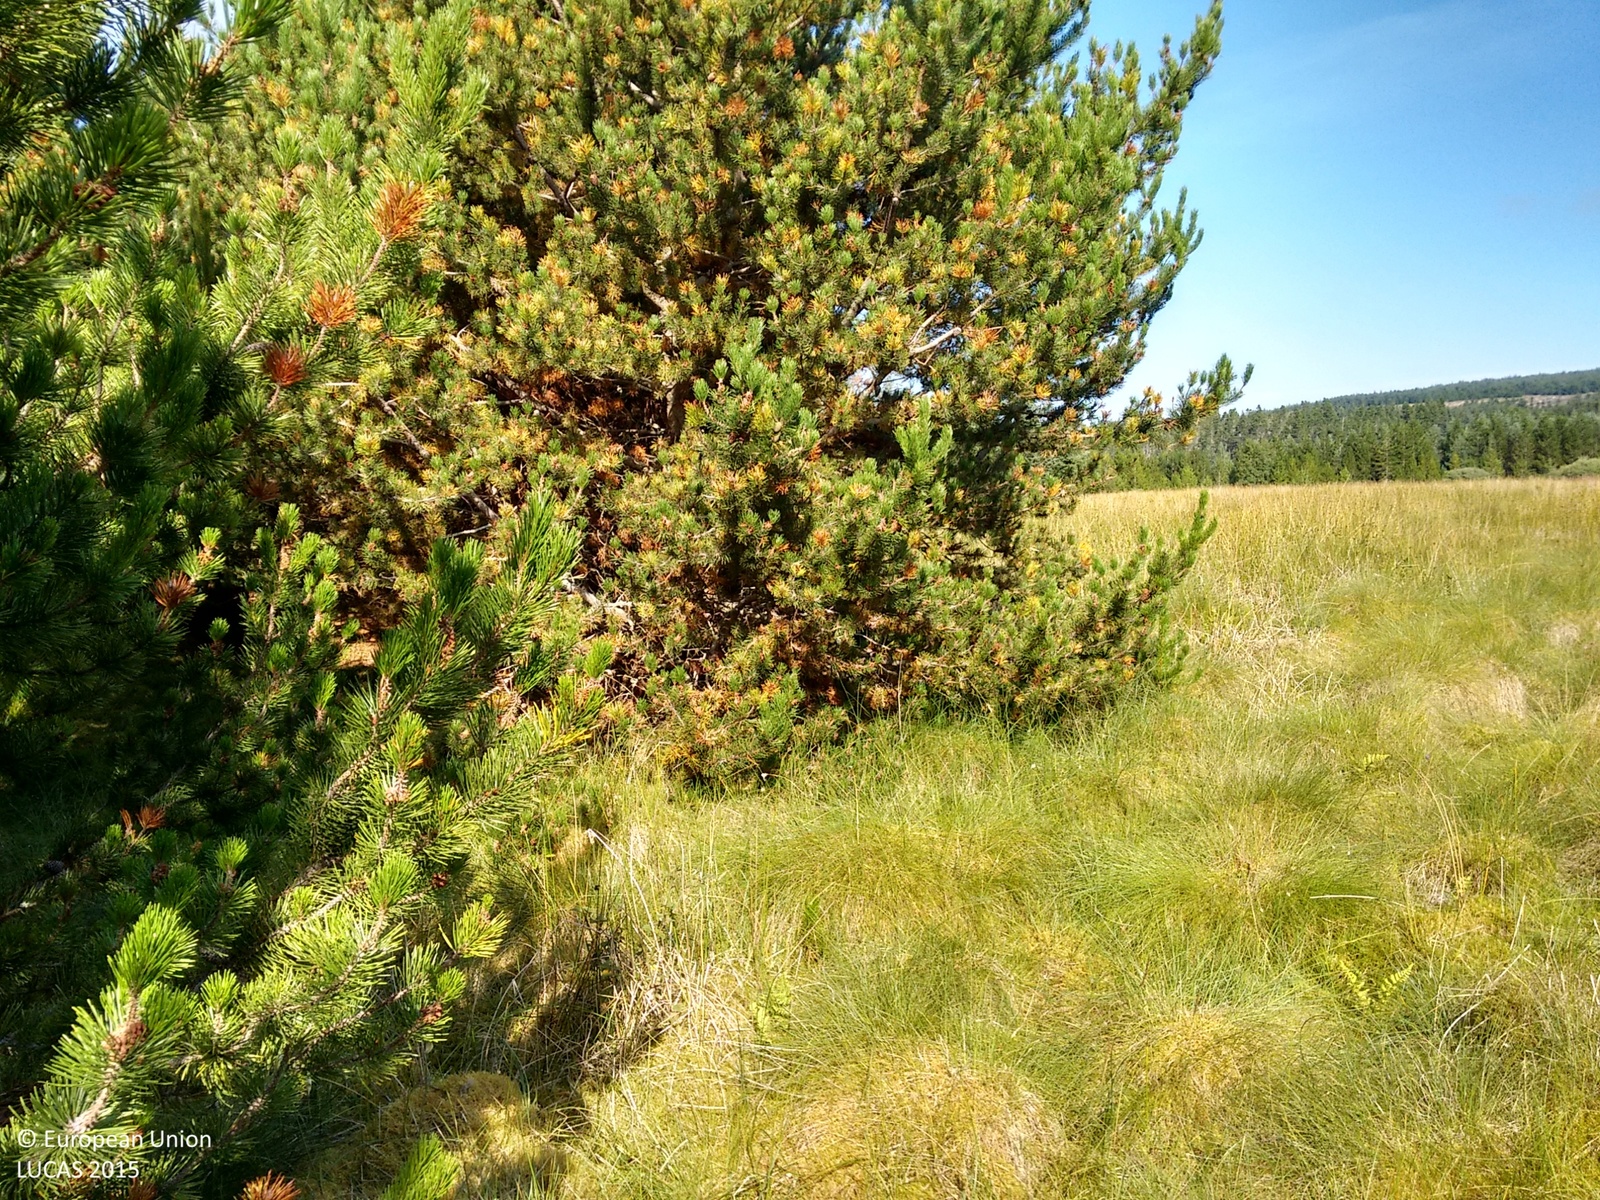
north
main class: Woodland
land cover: Pine dominated mixed woodland
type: exotic forest
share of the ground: > 75 %
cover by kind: coniferous forest trees 45 %, herbaceous plants 30 %, broadleaved forest trees 15 %, lichens and mosses 10 %
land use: Forestry
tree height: > 5 m
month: September
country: GB
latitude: 58.0779
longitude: -4.4137
